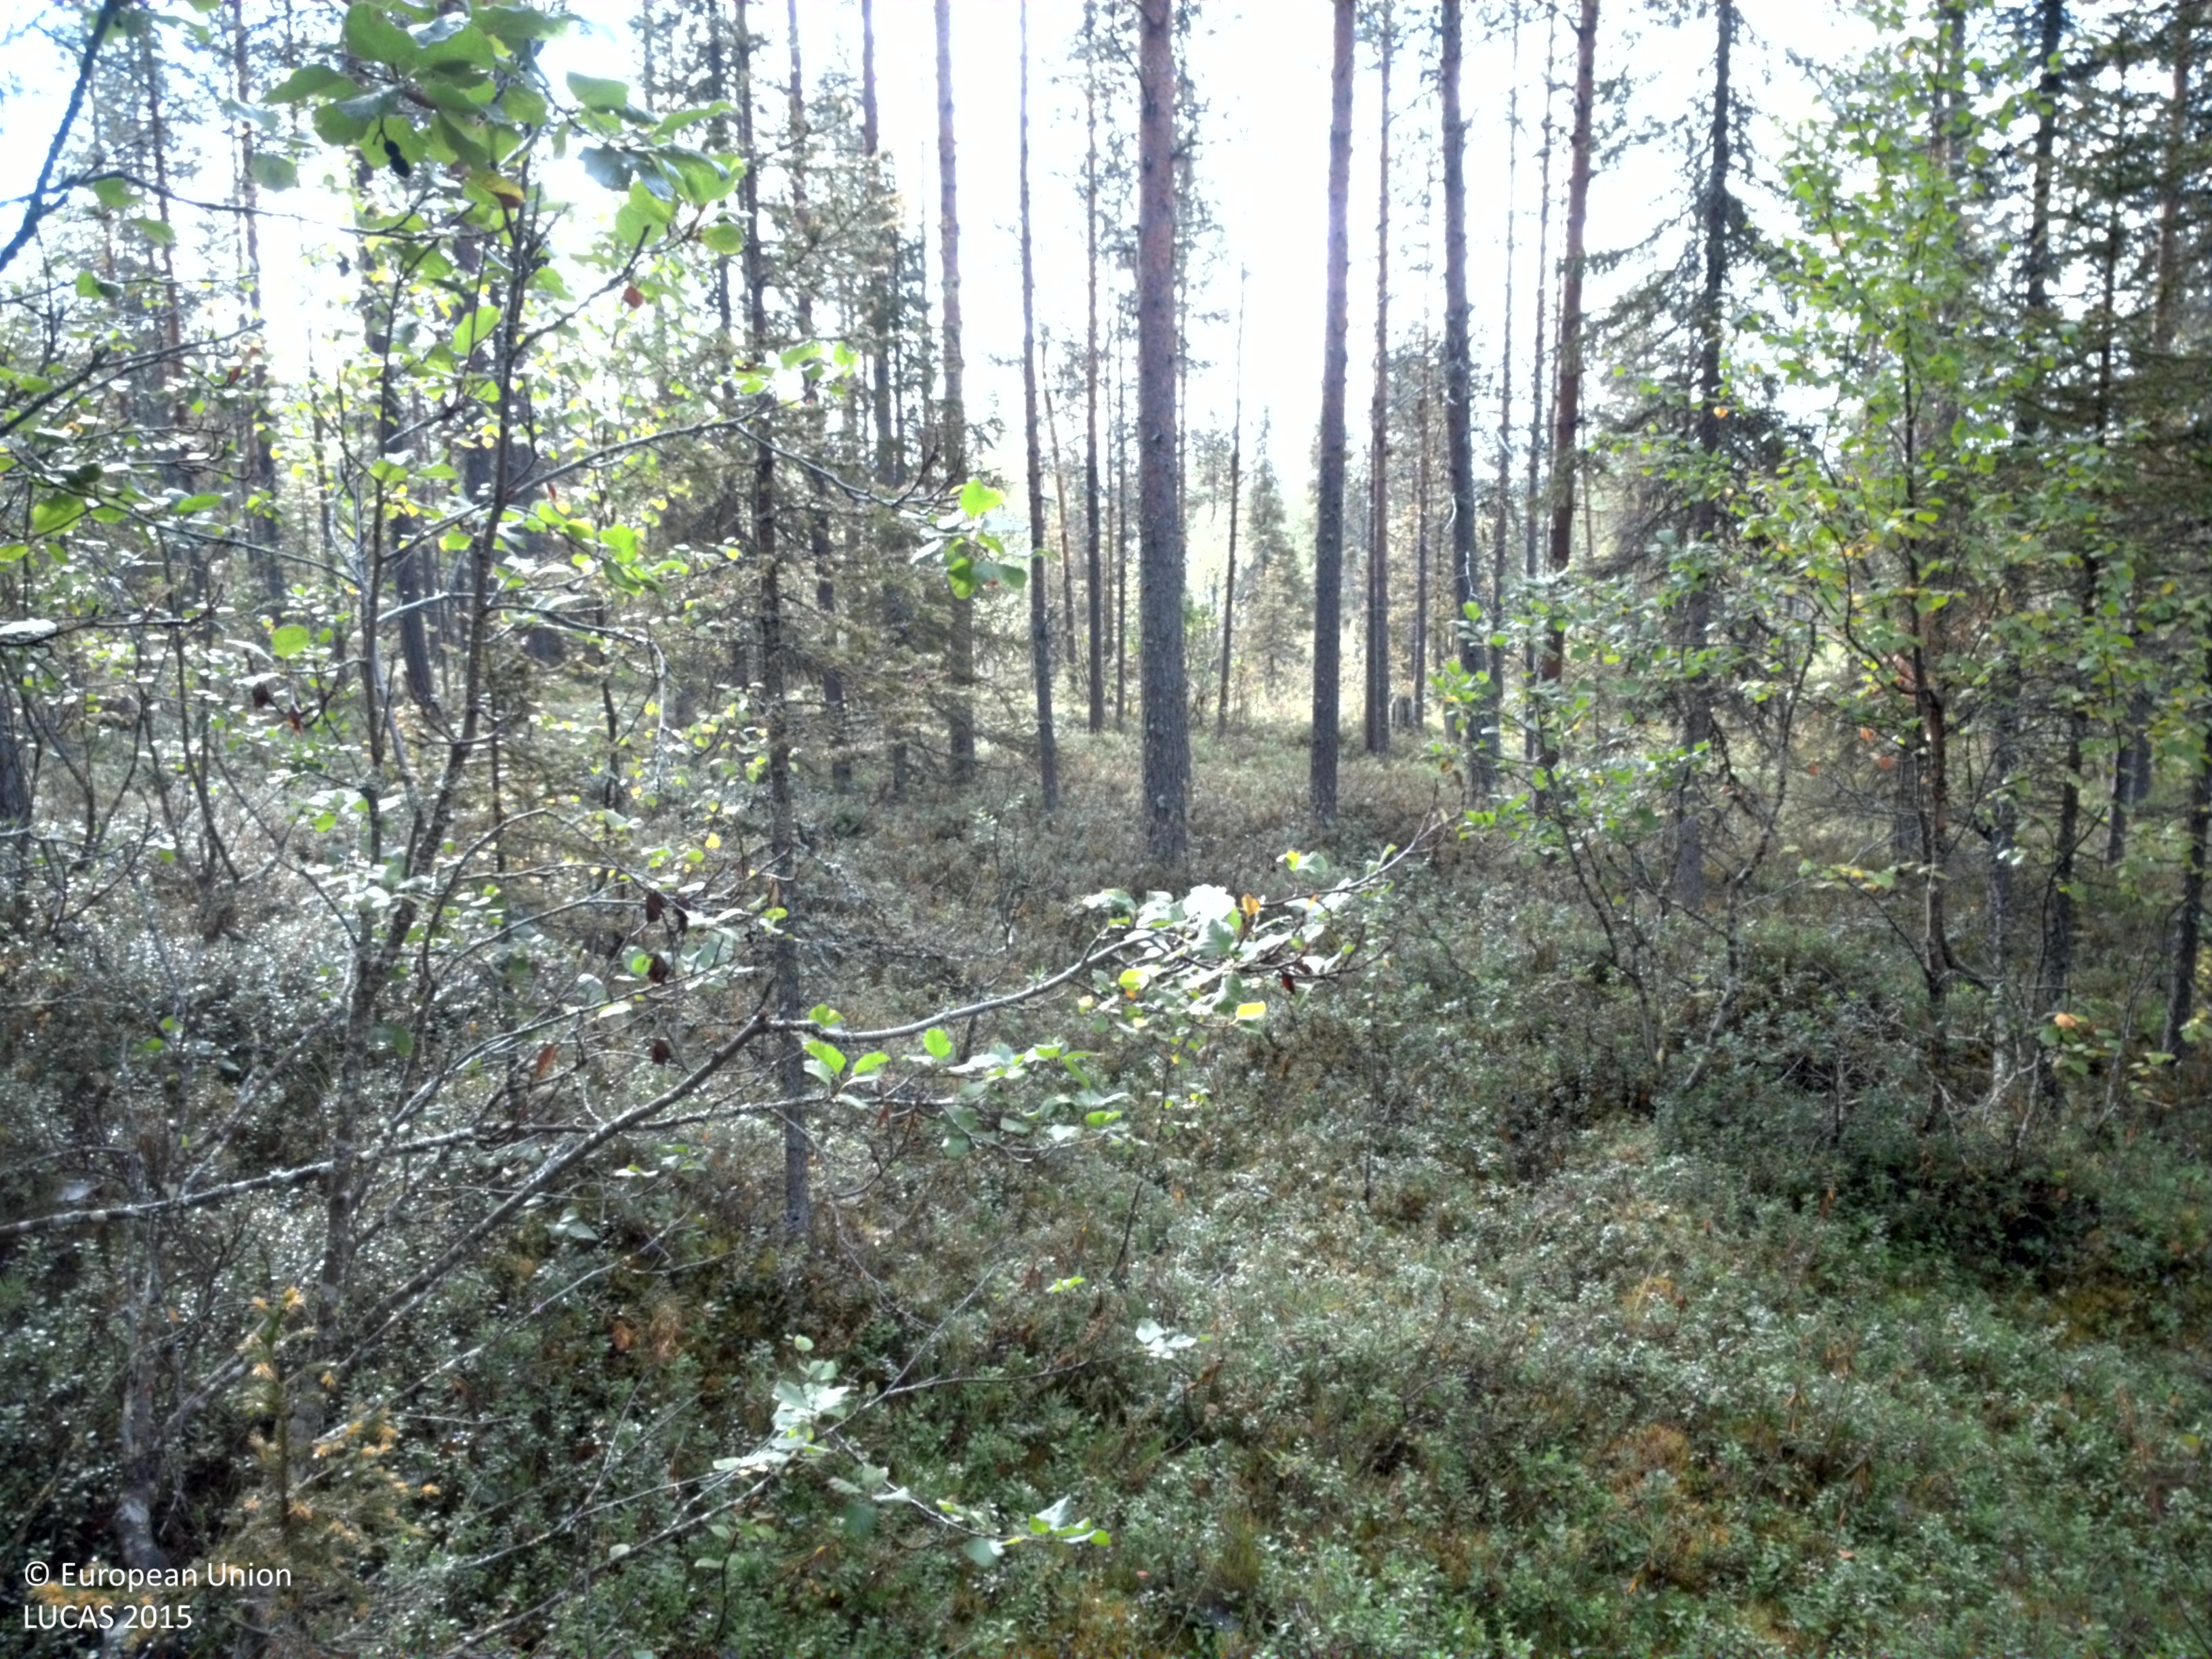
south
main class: Woodland
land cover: Pine dominated coniferous woodland
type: boreal forest
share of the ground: 25 - 50 %
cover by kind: shrubs 65 %, coniferous forest trees 30 %, broadleaved forest trees 5 %
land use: Forestry
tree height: > 5 m
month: August
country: SE
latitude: 66.5855
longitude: 19.6264
